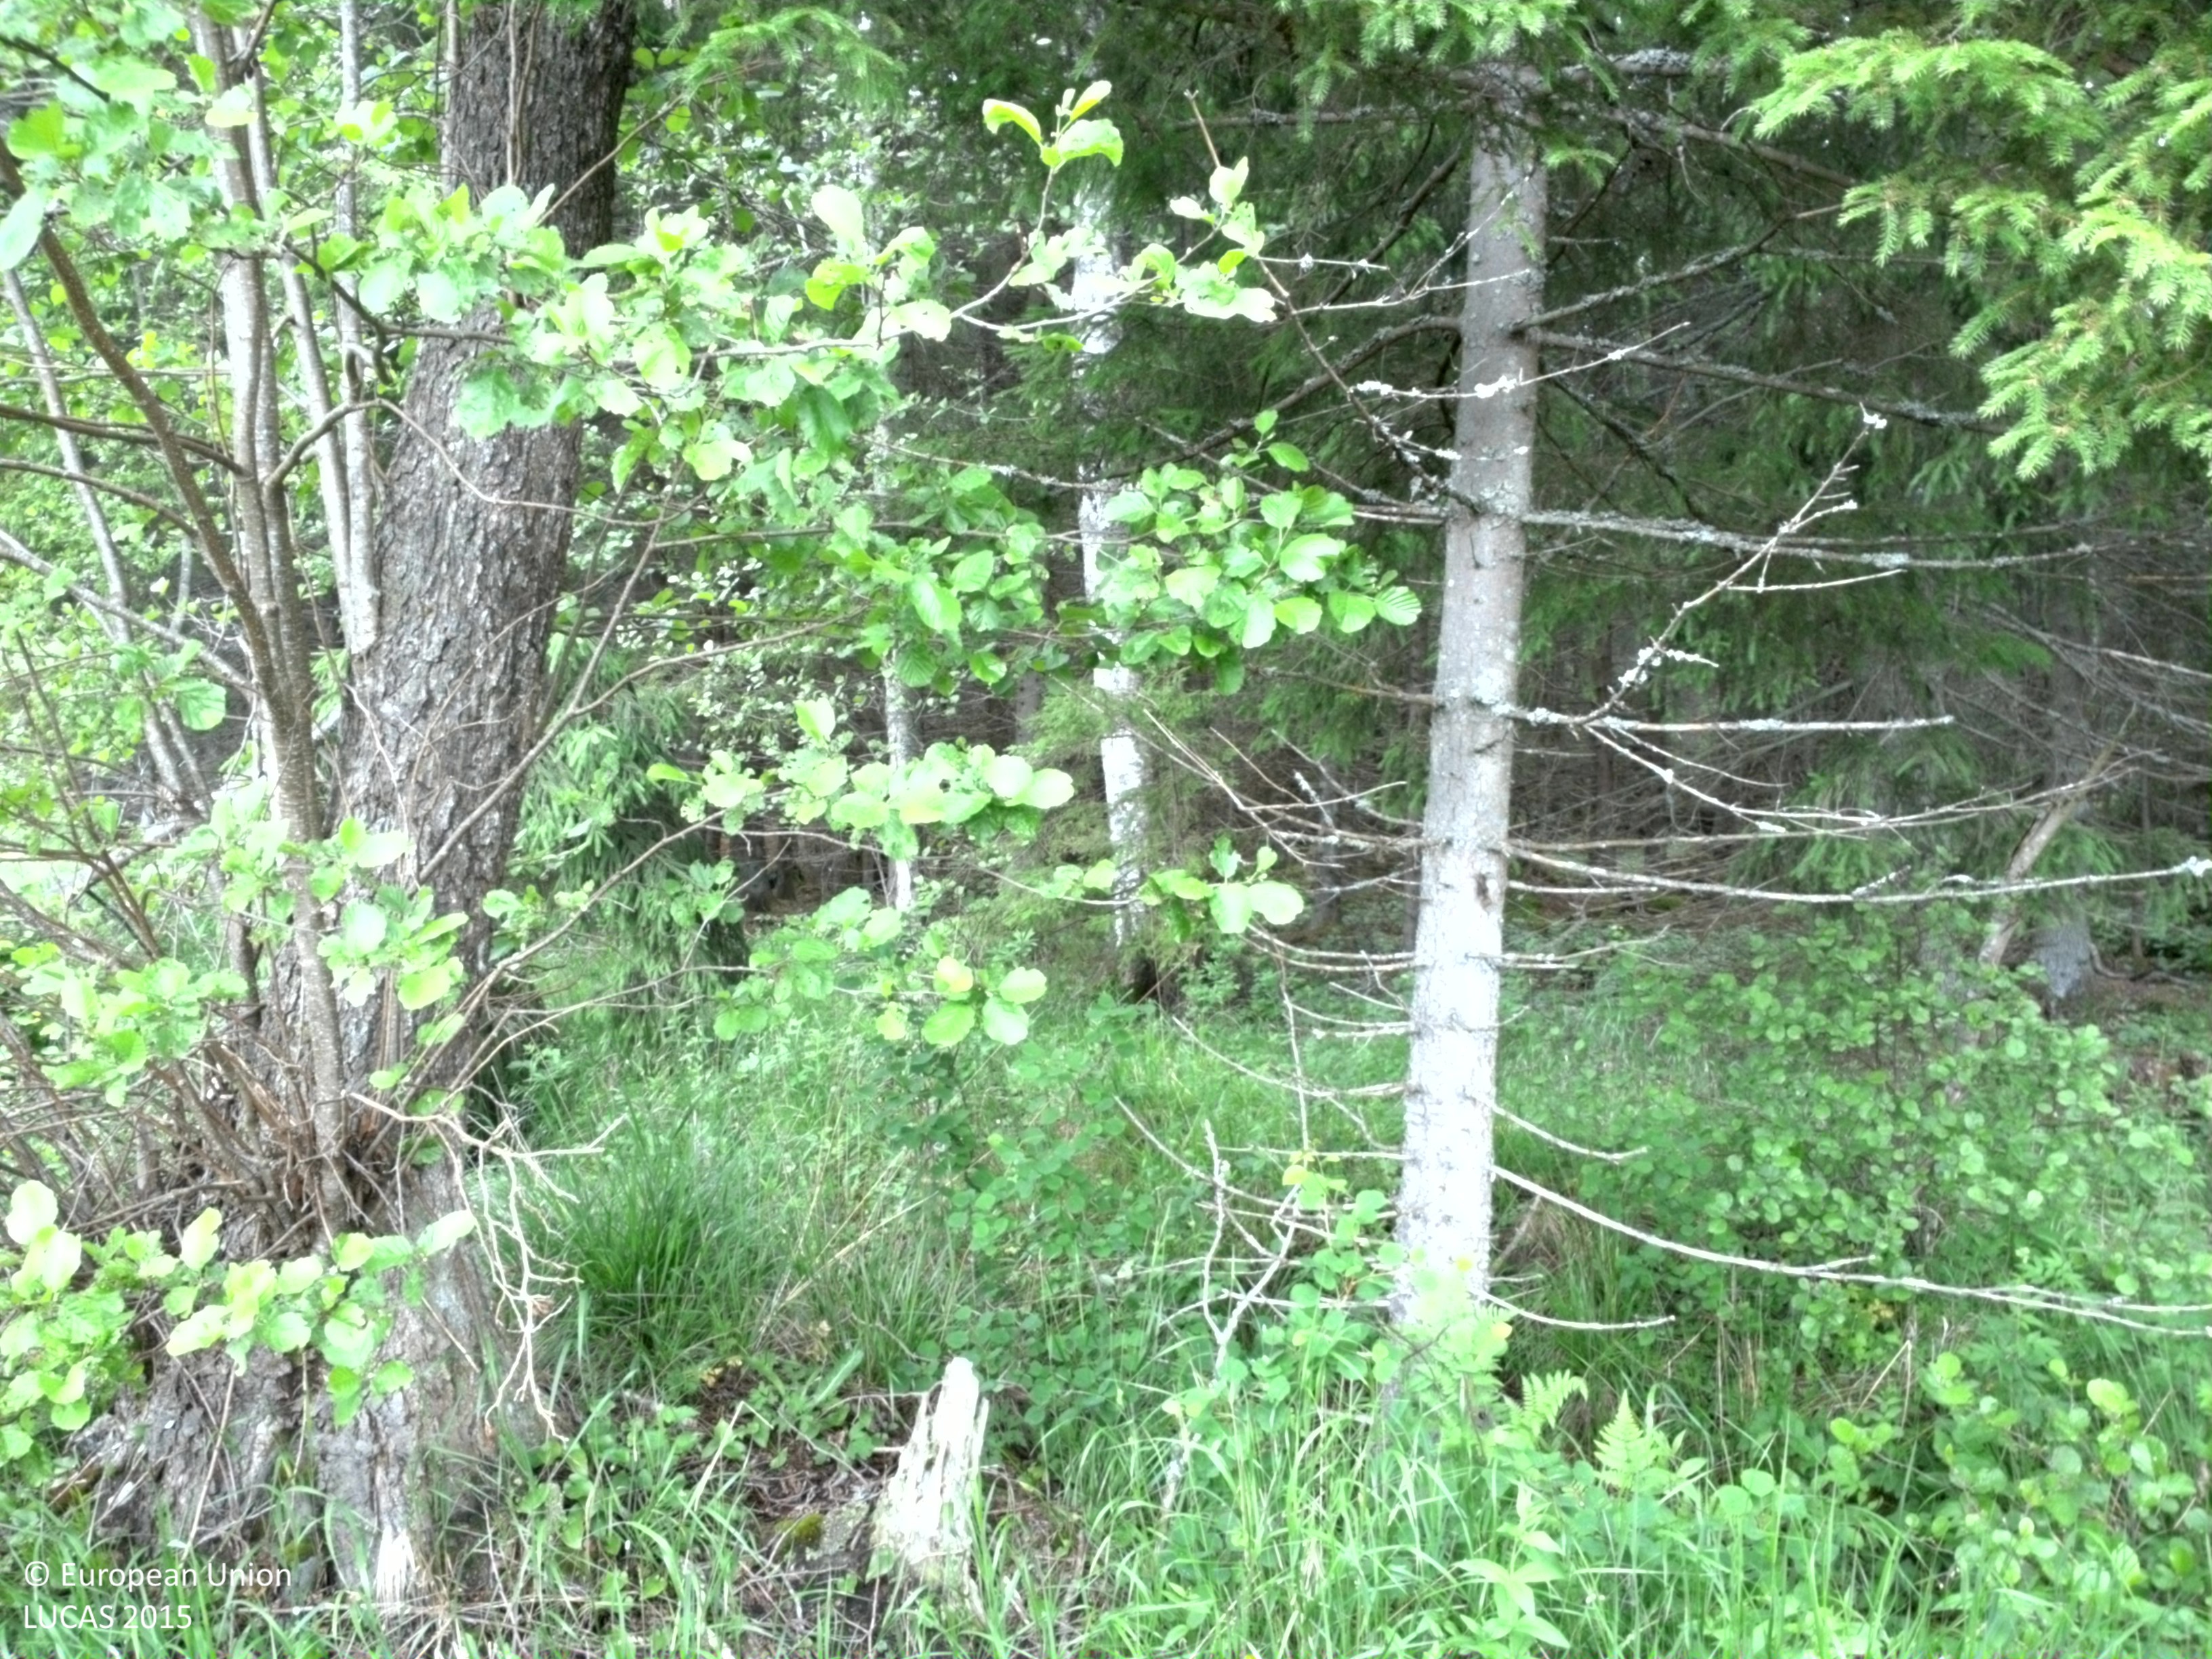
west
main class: Shrubland
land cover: Shrubland with sparse tree cover
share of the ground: 25 - 50 %
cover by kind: shrubs 40 %, herbaceous plants 30 %, lichens and mosses 25 %, coniferous forest trees 5 %
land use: Forestry
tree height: < 5 m
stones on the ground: < 10 %
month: June
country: SE
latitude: 59.7149
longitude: 18.6576
